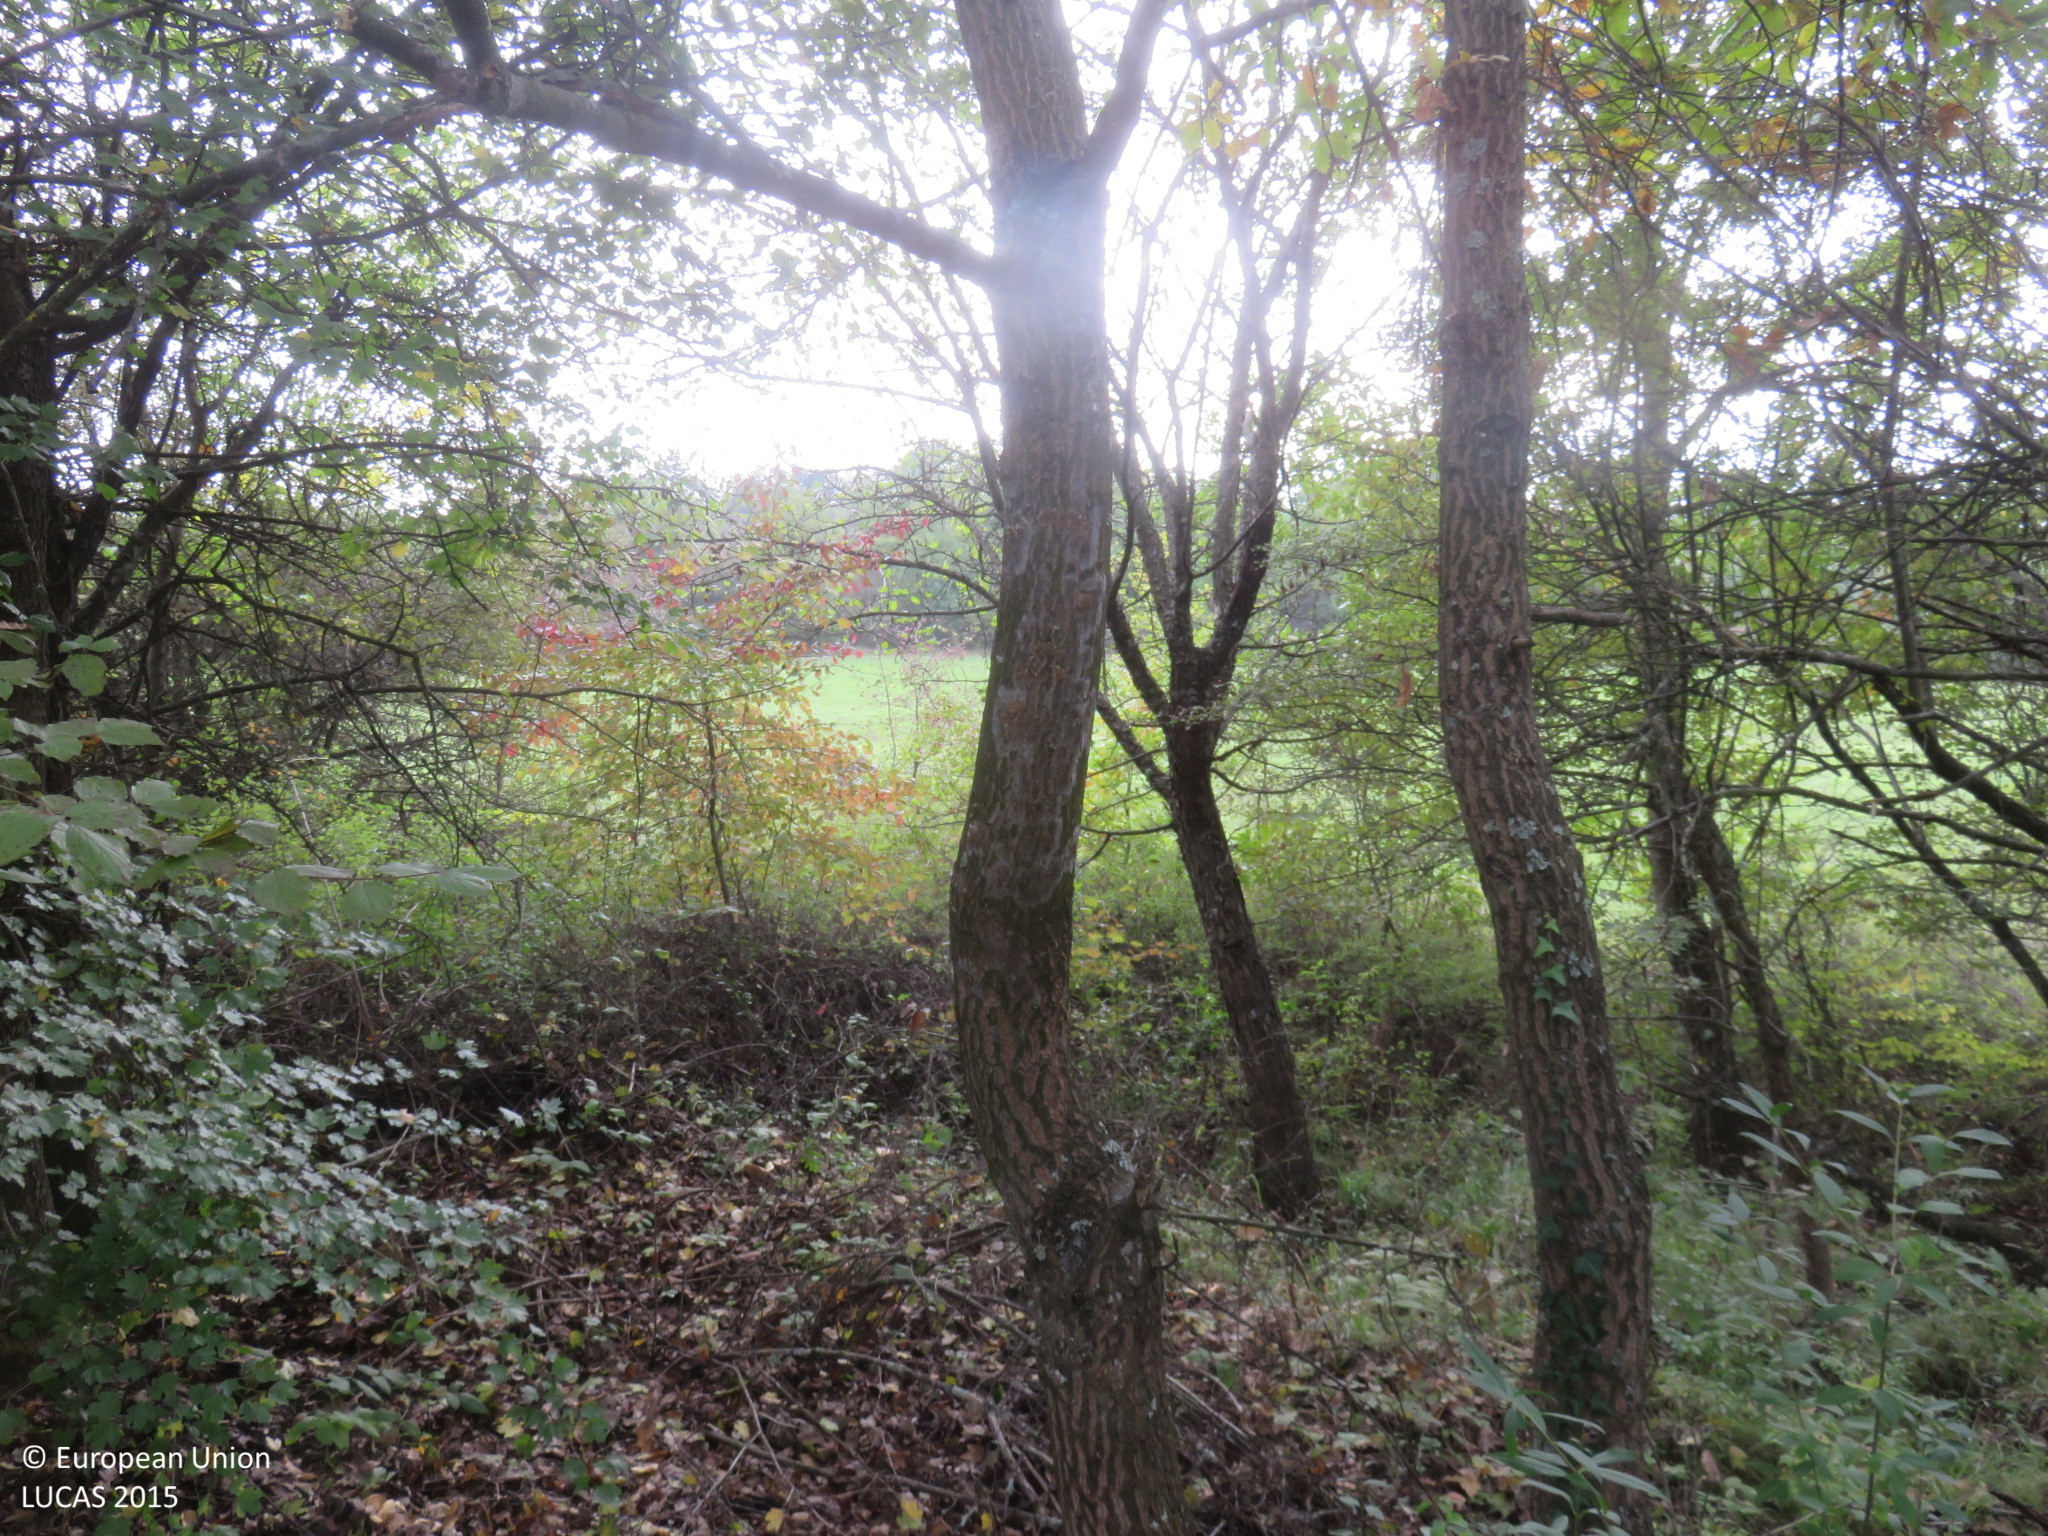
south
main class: Woodland
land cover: Broadleaved woodland
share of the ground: > 75 %
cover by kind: broadleaved forest trees 90 %, shrubs 5 %, herbaceous plants 5 %
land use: Semi-natural and natural areas not in use
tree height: < 5 m
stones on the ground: < 10 %
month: October
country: BG
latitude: 42.9119
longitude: 25.1966
